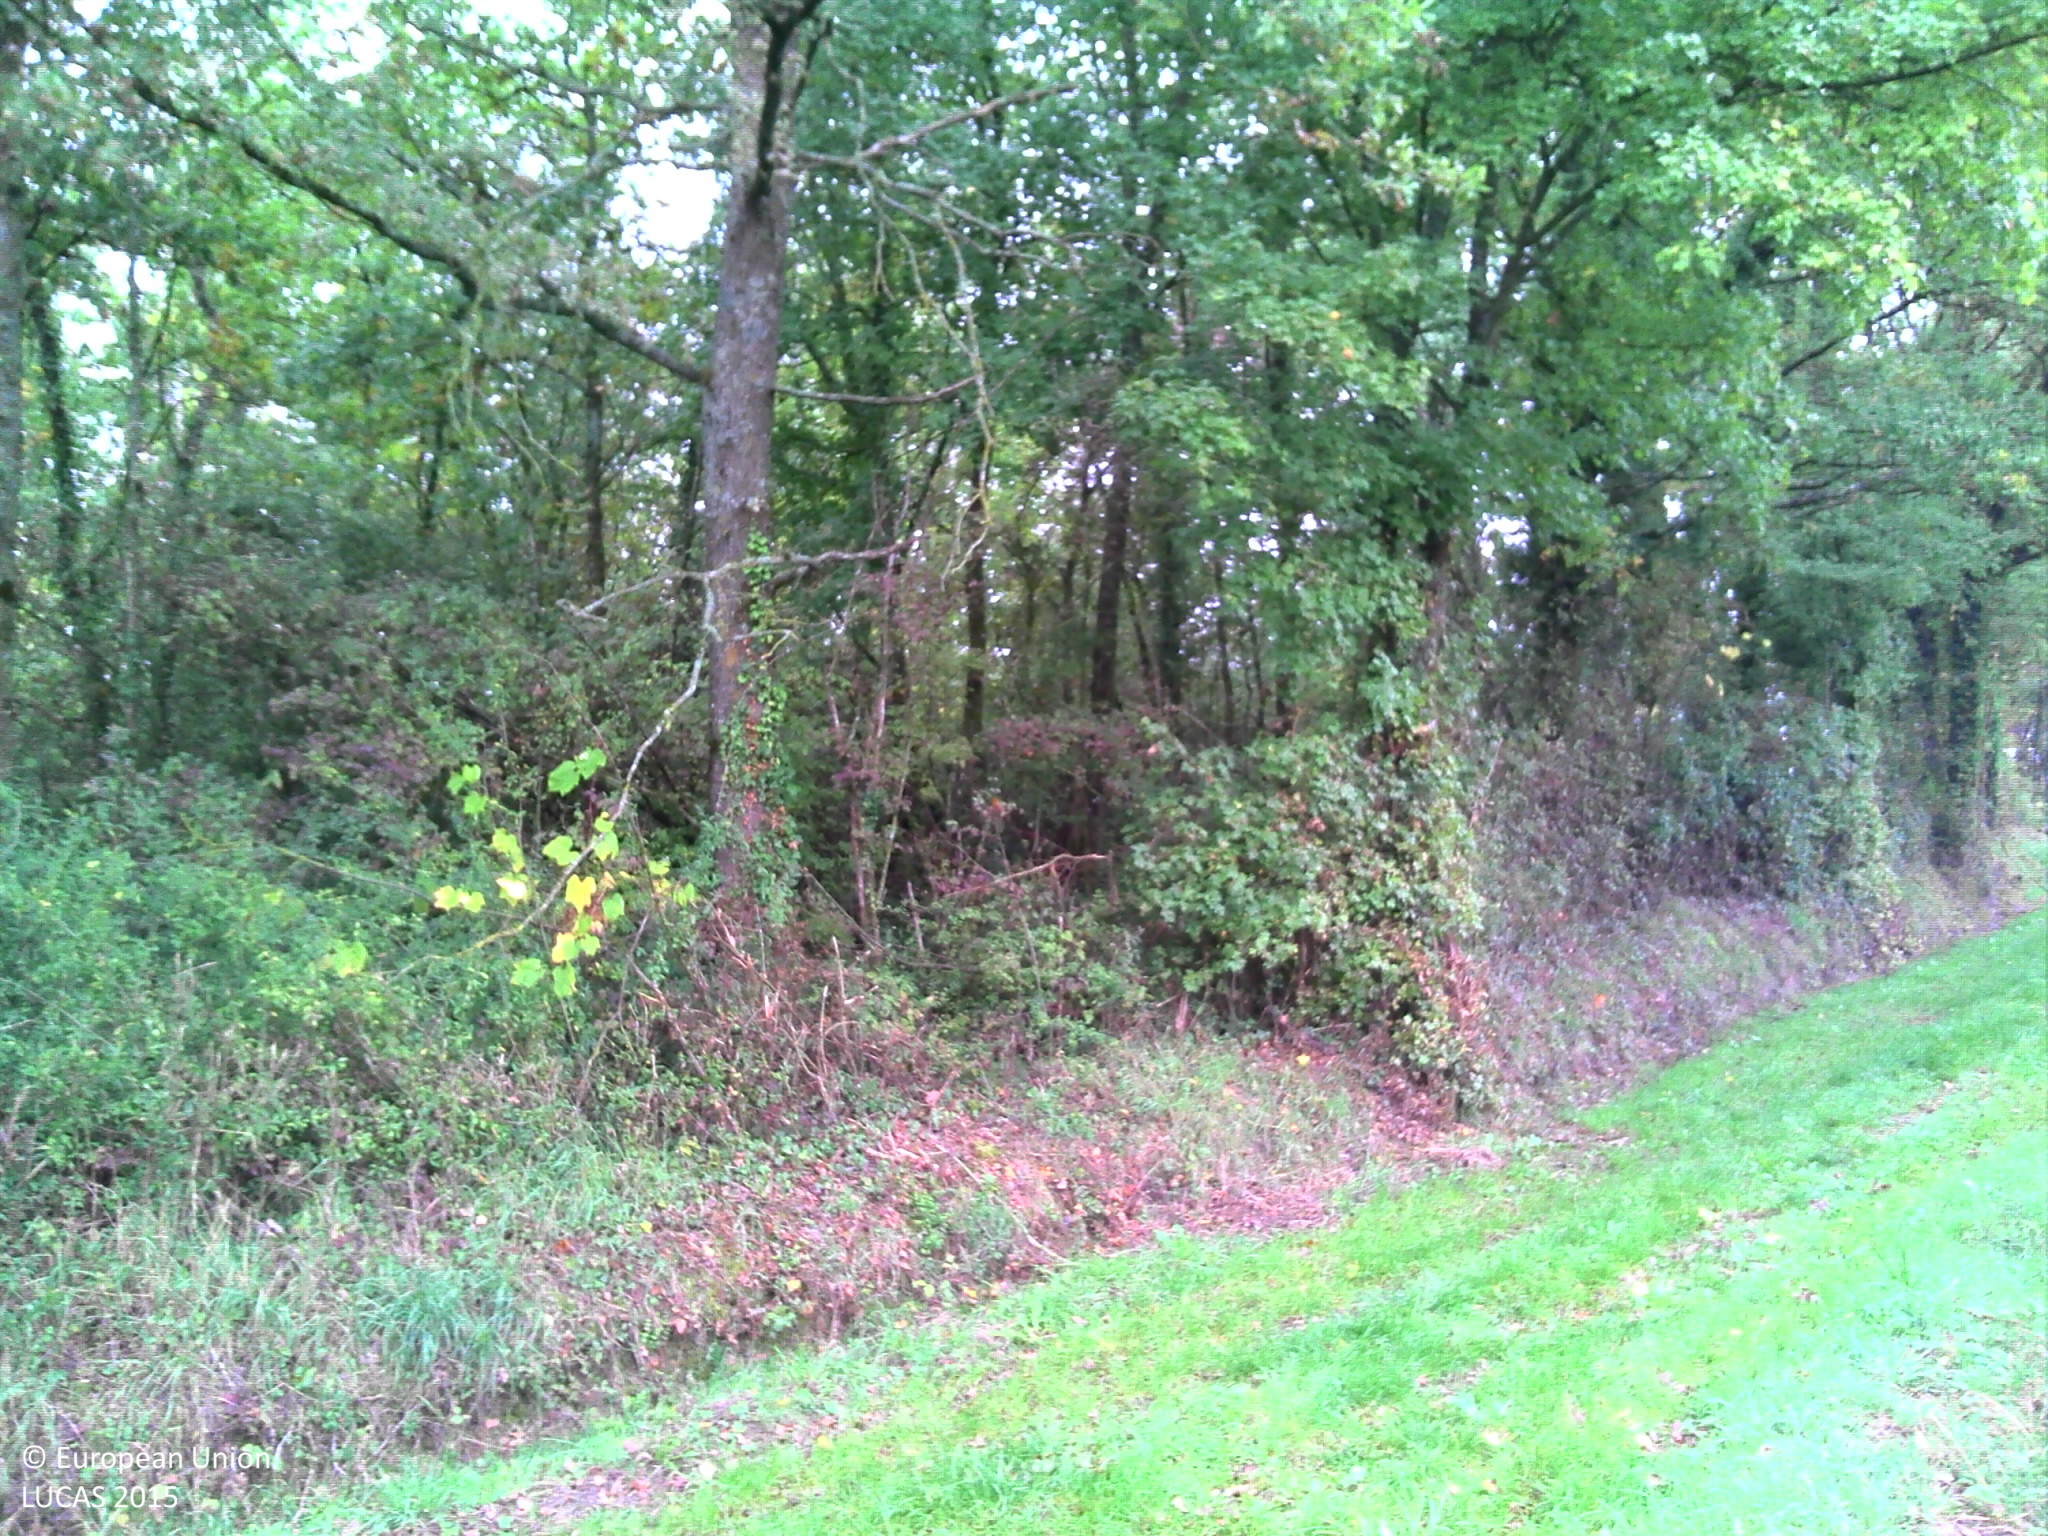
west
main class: Grassland
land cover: Grassland without tree/shrub cover
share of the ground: > 75 %
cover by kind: herbaceous plants 100 %
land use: Agriculture (excluding fallow land and kitchen gardens)
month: October
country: FR
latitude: 46.3246
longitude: 5.0019
